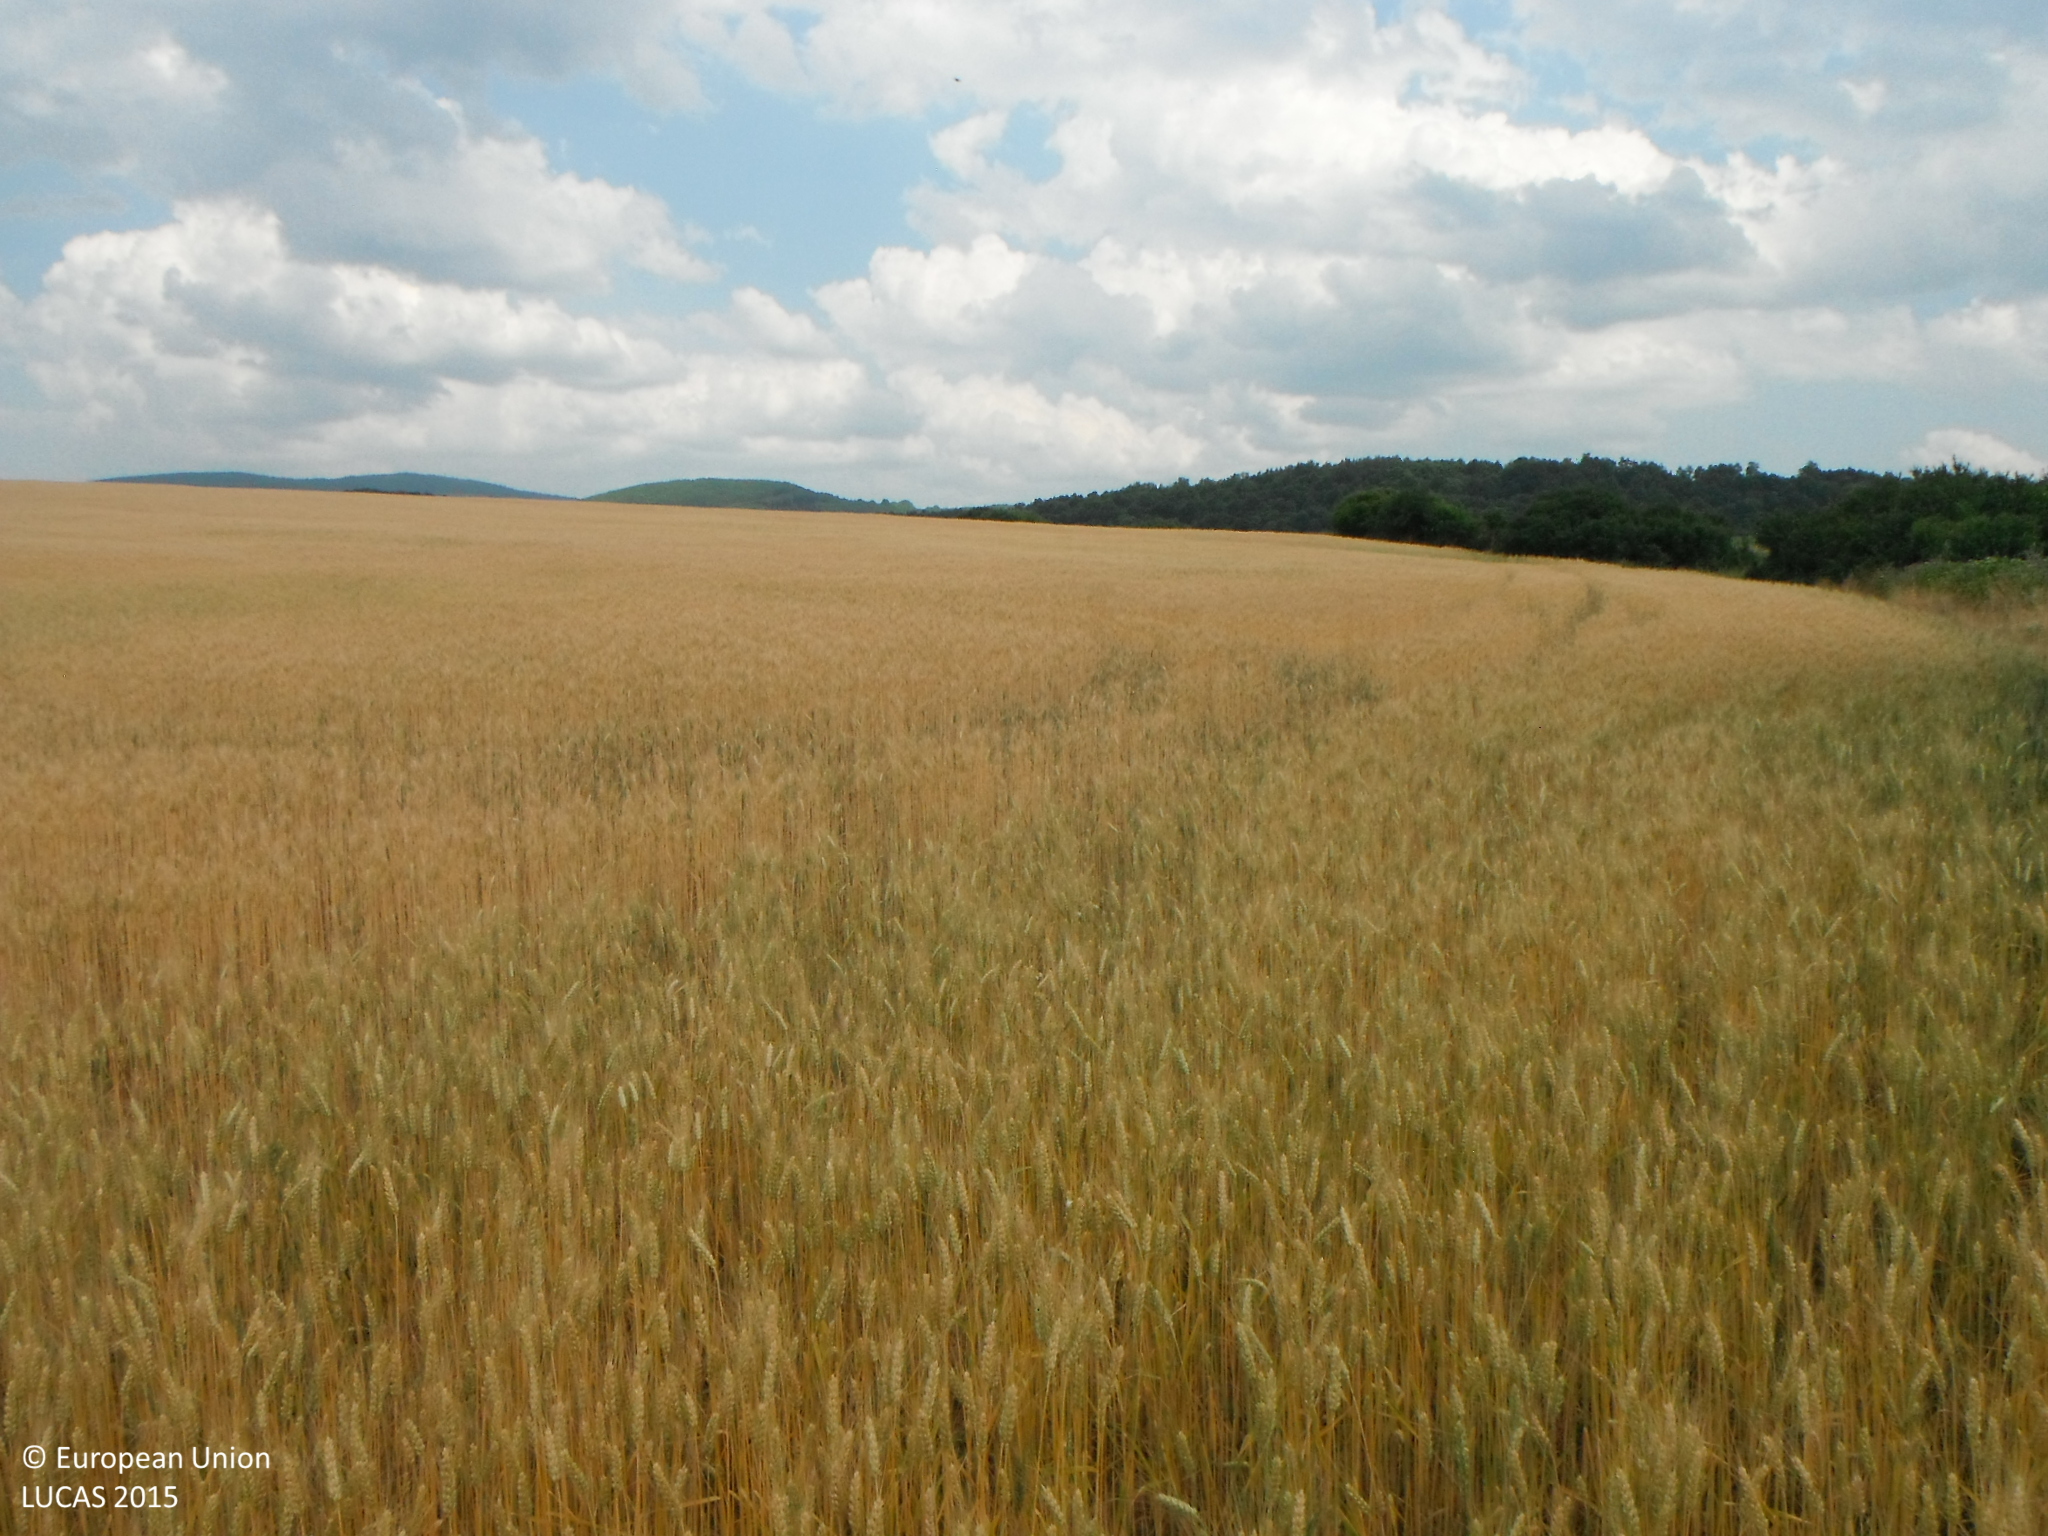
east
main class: Cropland
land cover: Common wheat
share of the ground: > 75 %
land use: Agriculture (excluding fallow land and kitchen gardens)
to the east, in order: Common wheat
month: July
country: SK
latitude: 48.4201
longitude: 19.1697
